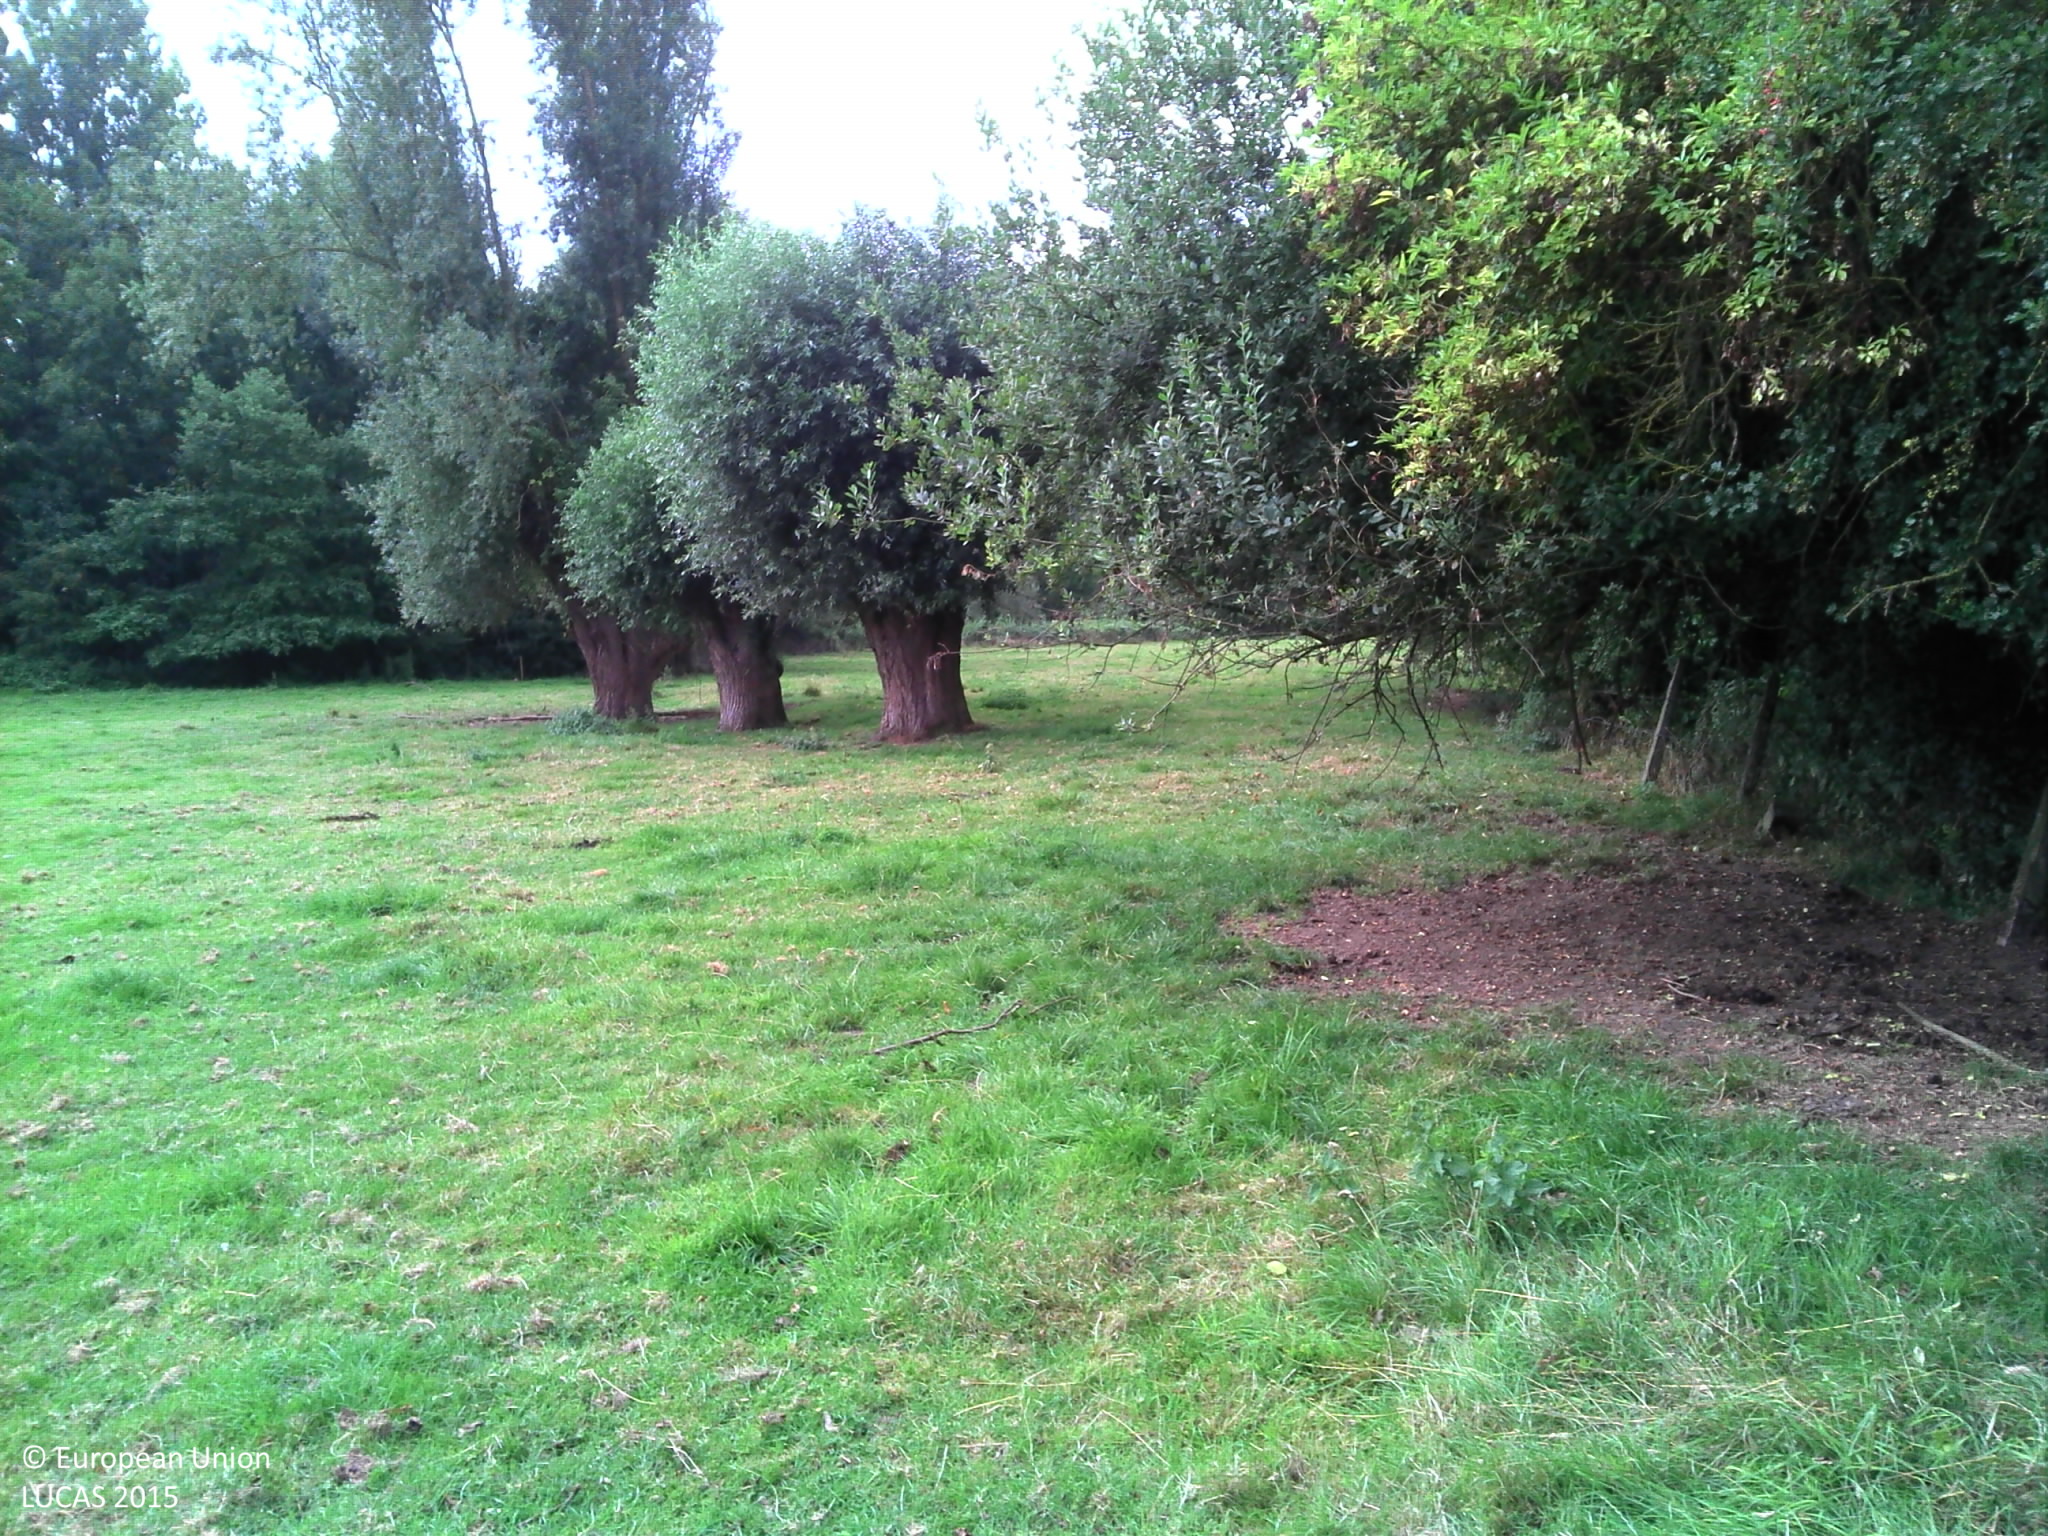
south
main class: Grassland
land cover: Grassland without tree/shrub cover
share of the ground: > 75 %
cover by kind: herbaceous plants 100 %
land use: Agriculture (excluding fallow land and kitchen gardens)
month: August
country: BE
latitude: 50.6817
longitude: 3.7803
